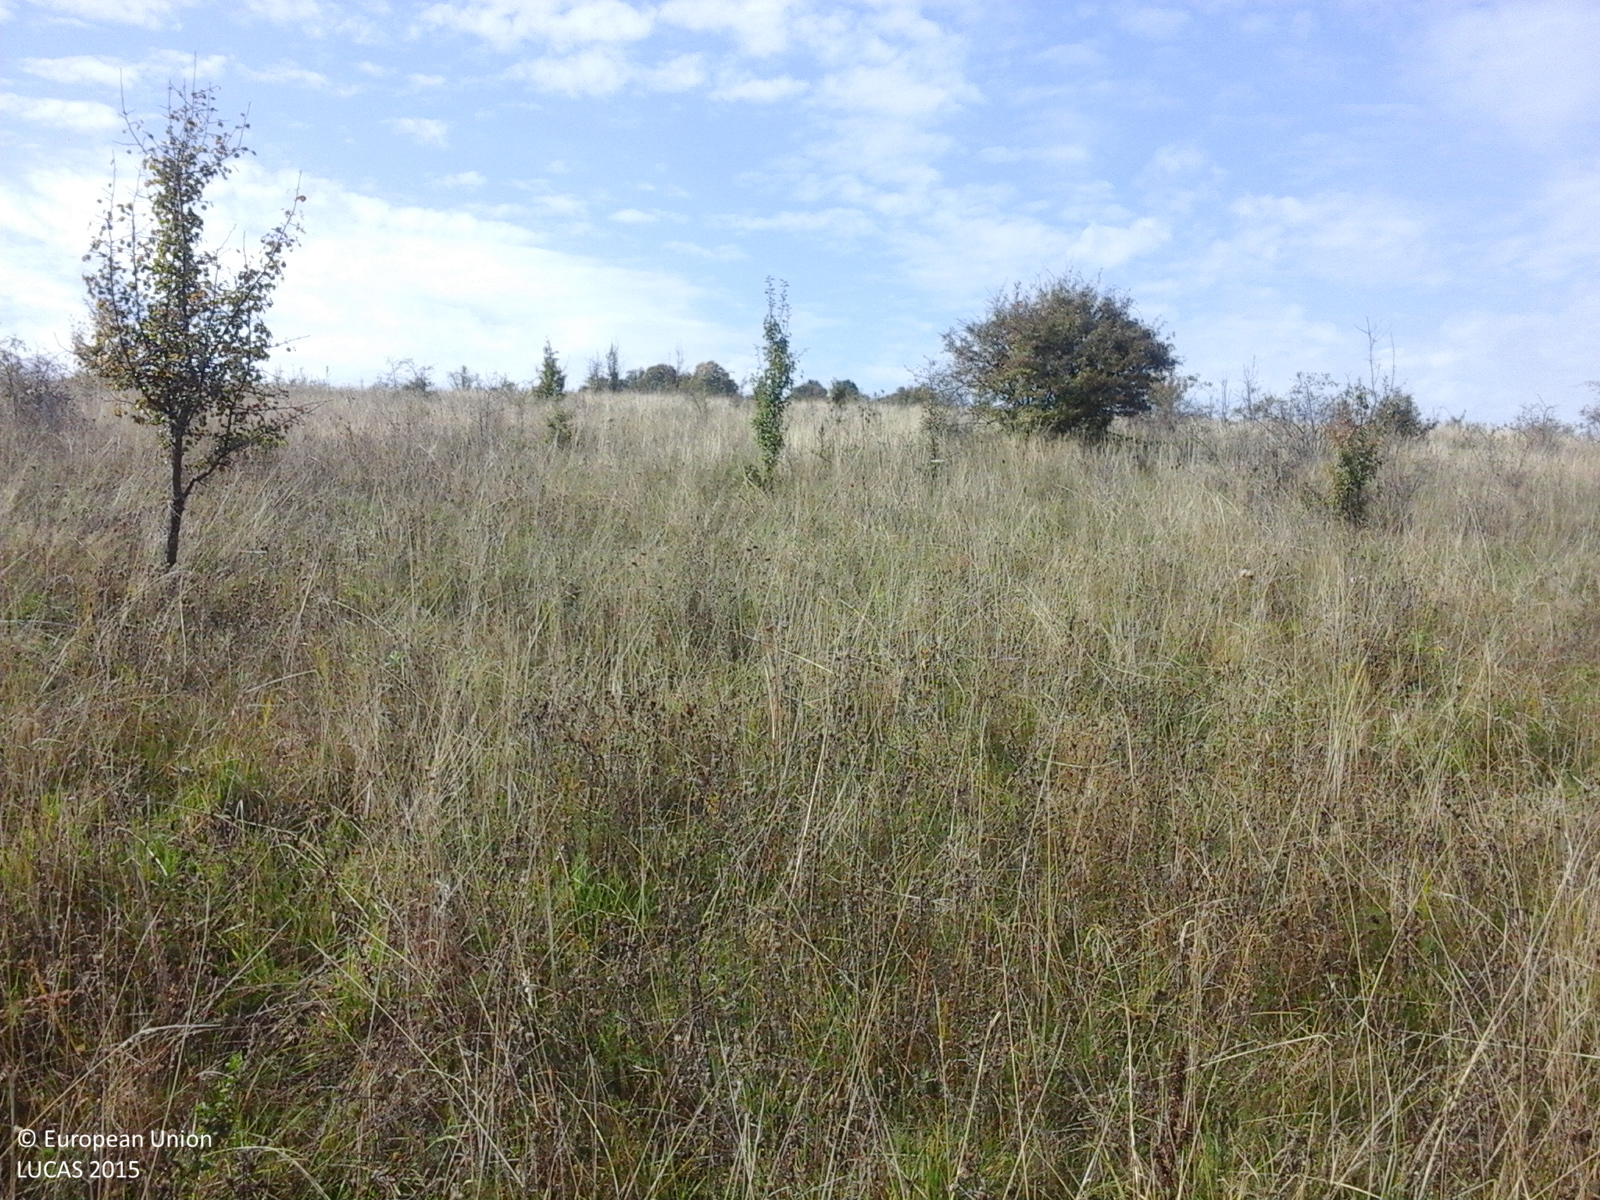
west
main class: Grassland
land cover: Grassland with sparse tree/shrub cover
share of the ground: > 75 %
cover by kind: herbaceous plants 85 %, shrubs 10 %, broadleaved forest trees 5 %
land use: Agriculture (excluding fallow land and kitchen gardens)
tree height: > 5 m
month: October
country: RO
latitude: 46.4247
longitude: 25.1023
